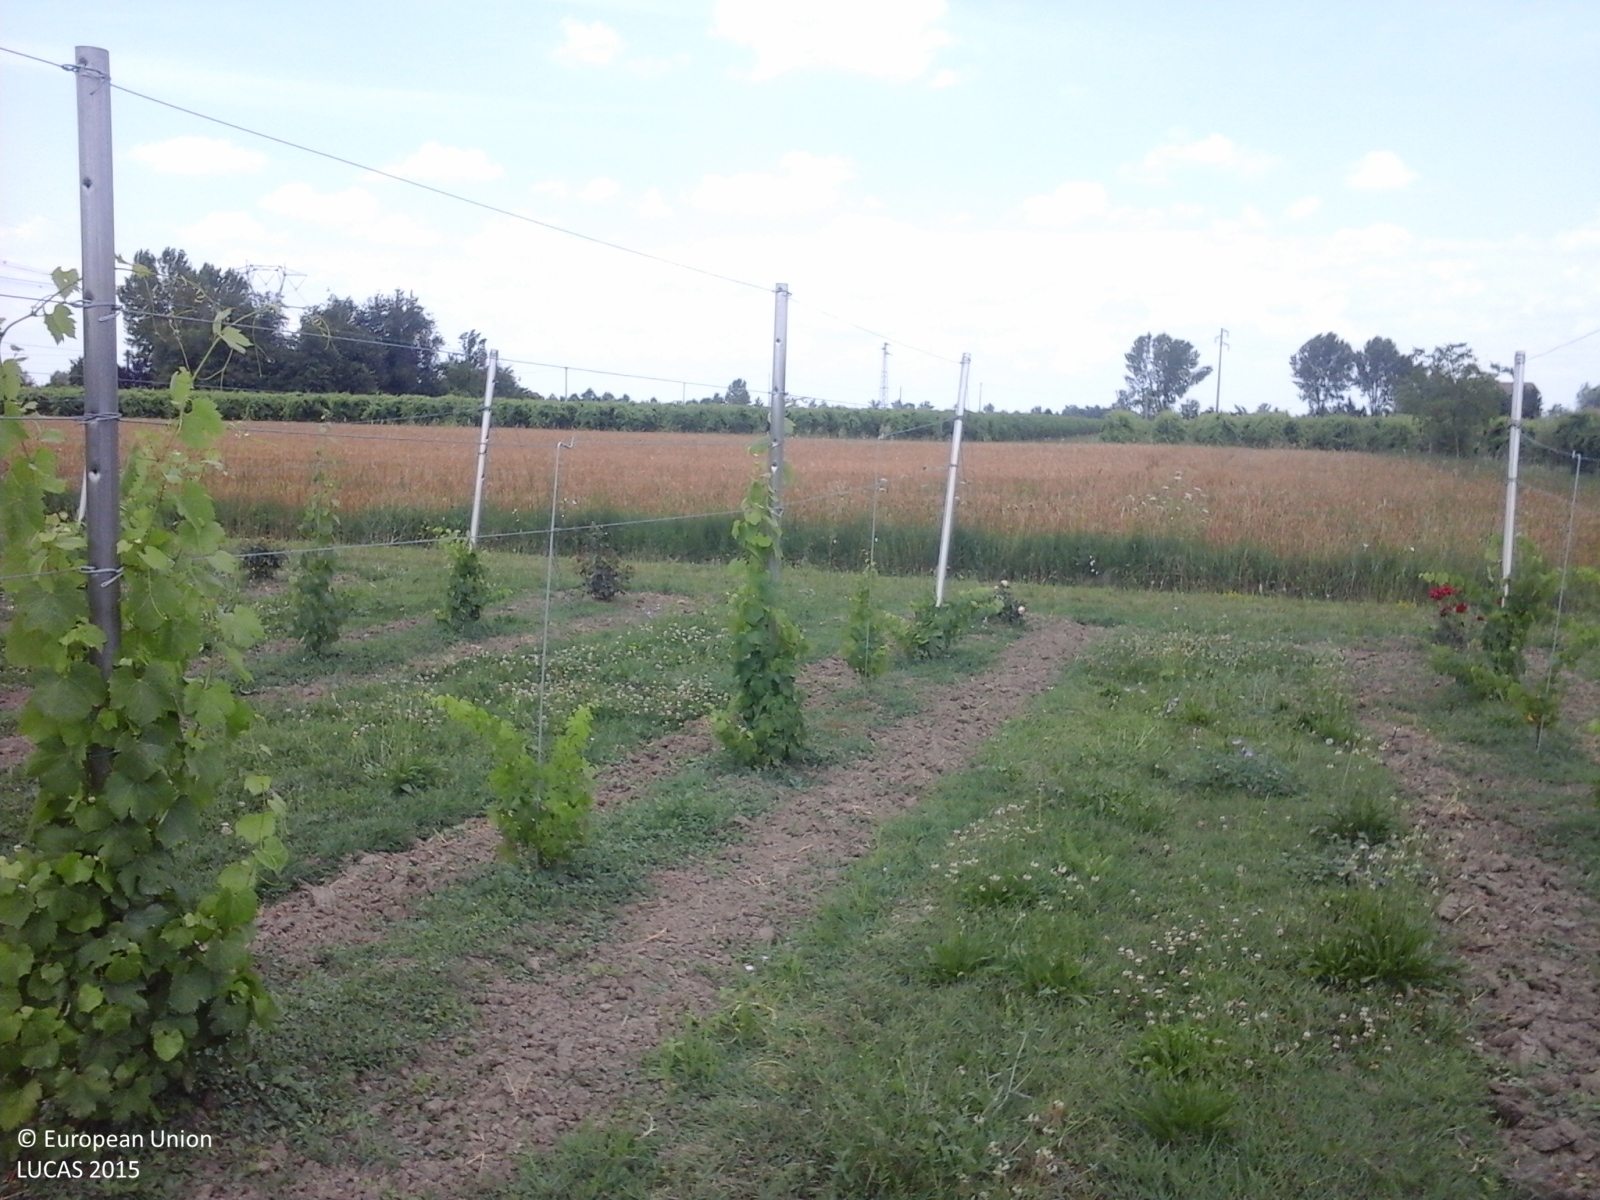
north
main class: Cropland
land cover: Vineyards
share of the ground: 25 - 50 %
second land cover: Grassland without tree/shrub cover
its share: > 75 %
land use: Agriculture (excluding fallow land and kitchen gardens)
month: June
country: IT
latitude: 44.7791
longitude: 10.9459
